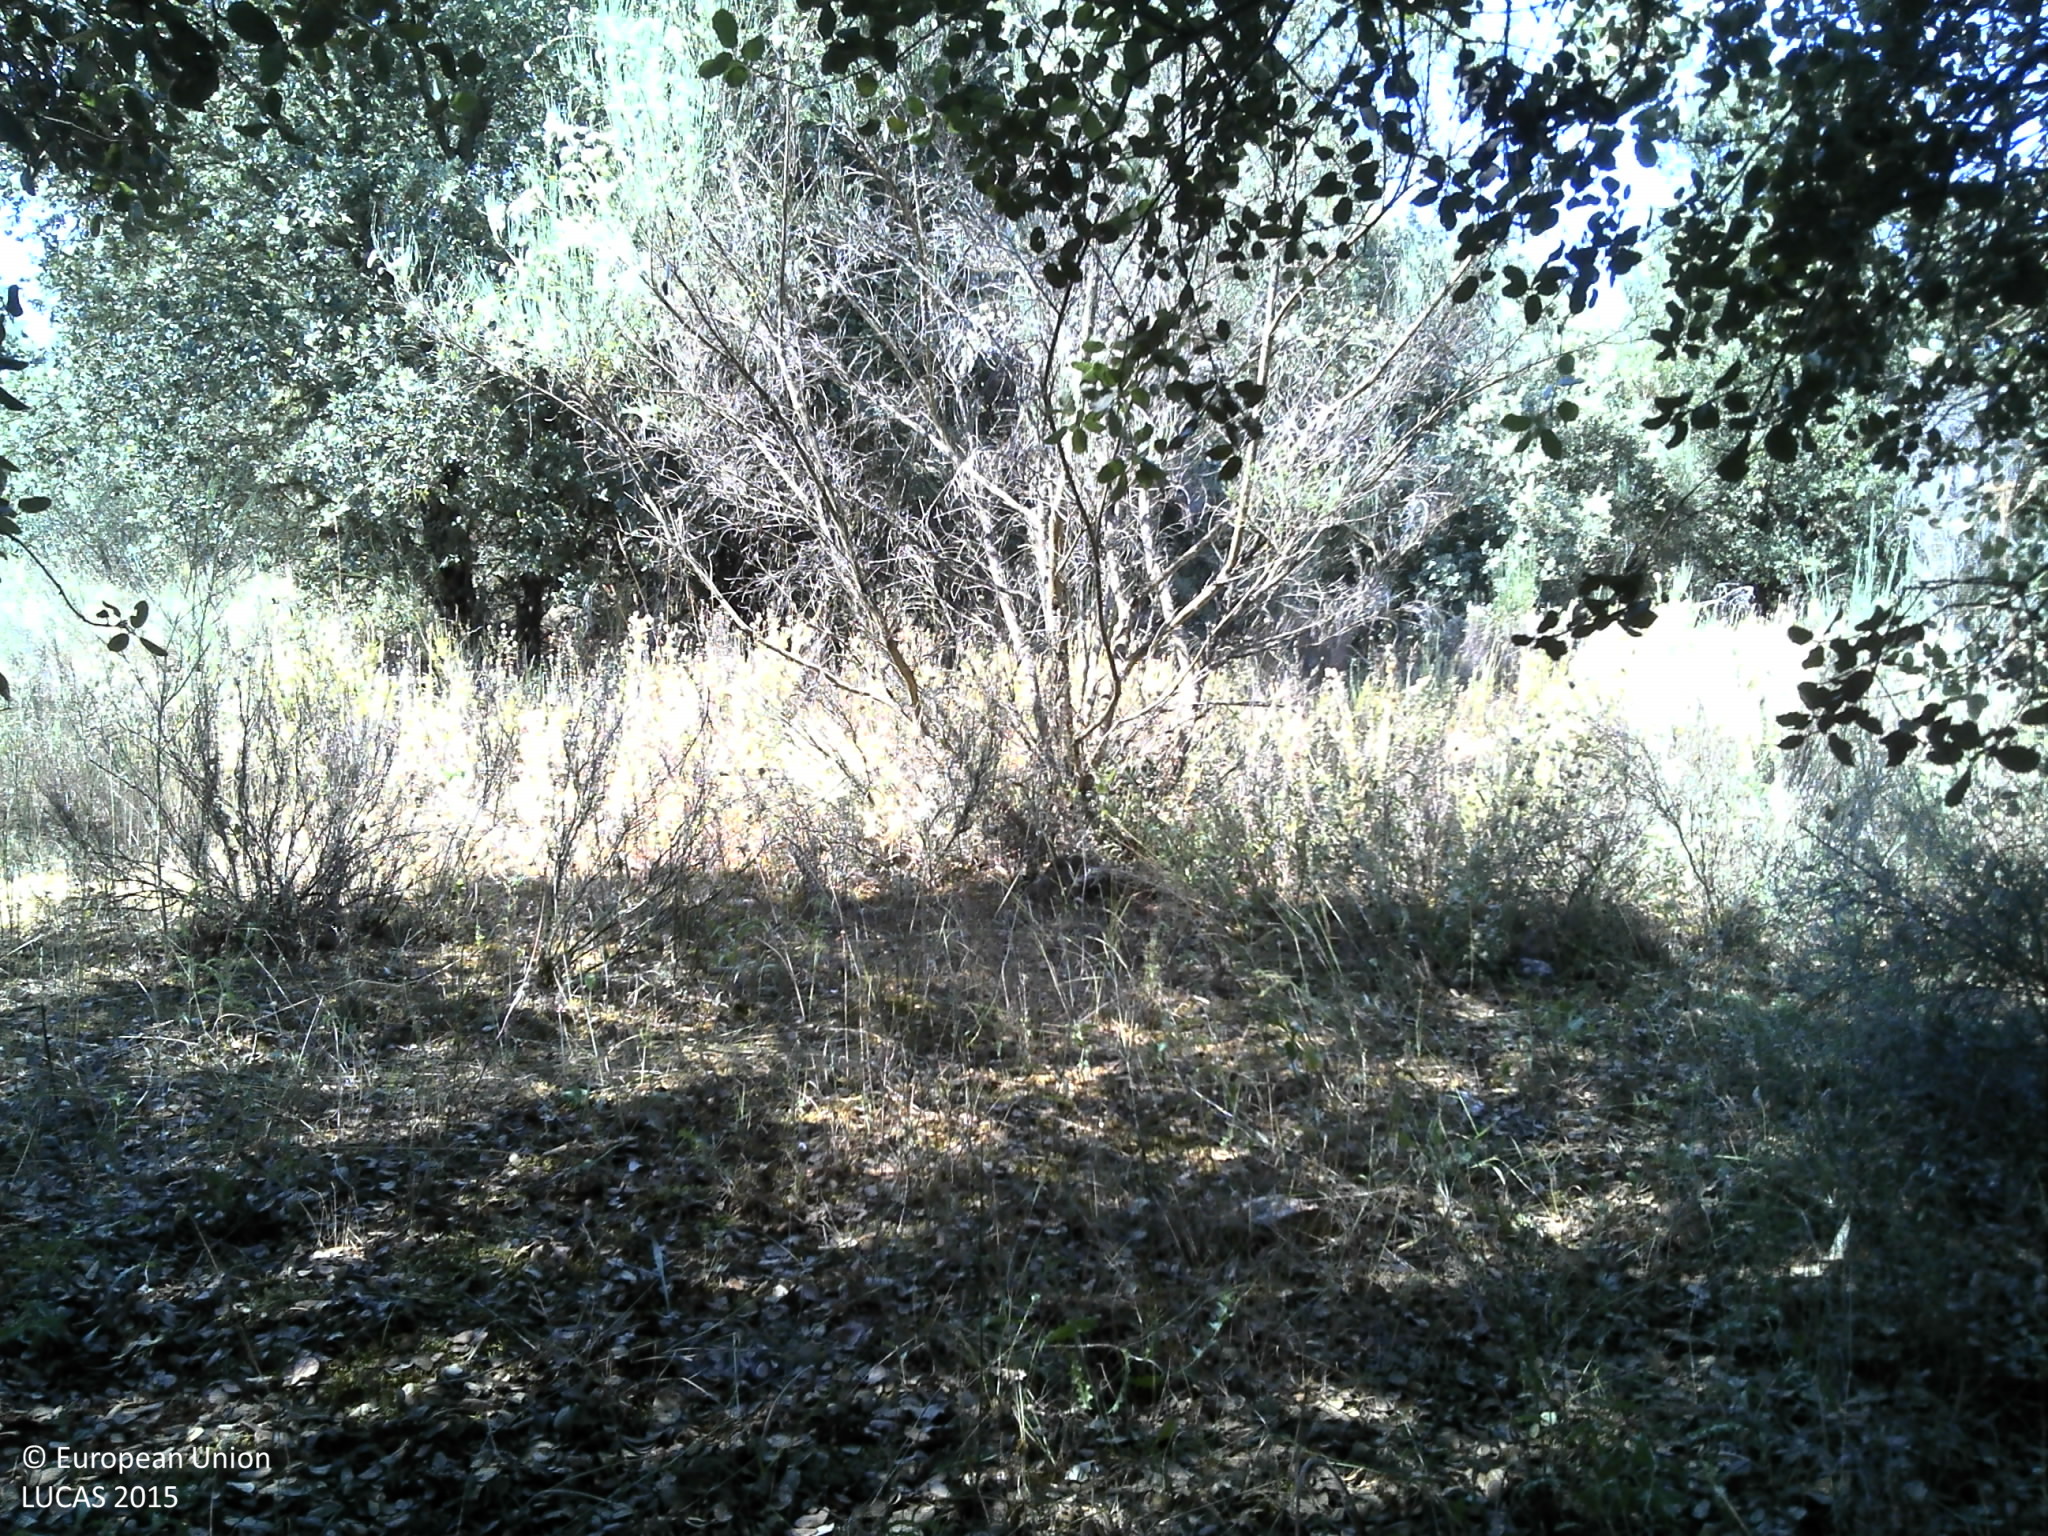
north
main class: Woodland
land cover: Broadleaved woodland
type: broadleaved evergreen forest
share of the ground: 25 - 50 %
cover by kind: shrubs 40 %, herbaceous plants 30 %, broadleaved forest trees 25 %, unconsolidated bare surface 5 %
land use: Forestry
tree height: > 5 m
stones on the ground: < 10 %
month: June
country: PT
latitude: 40.8556
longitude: -6.8875
